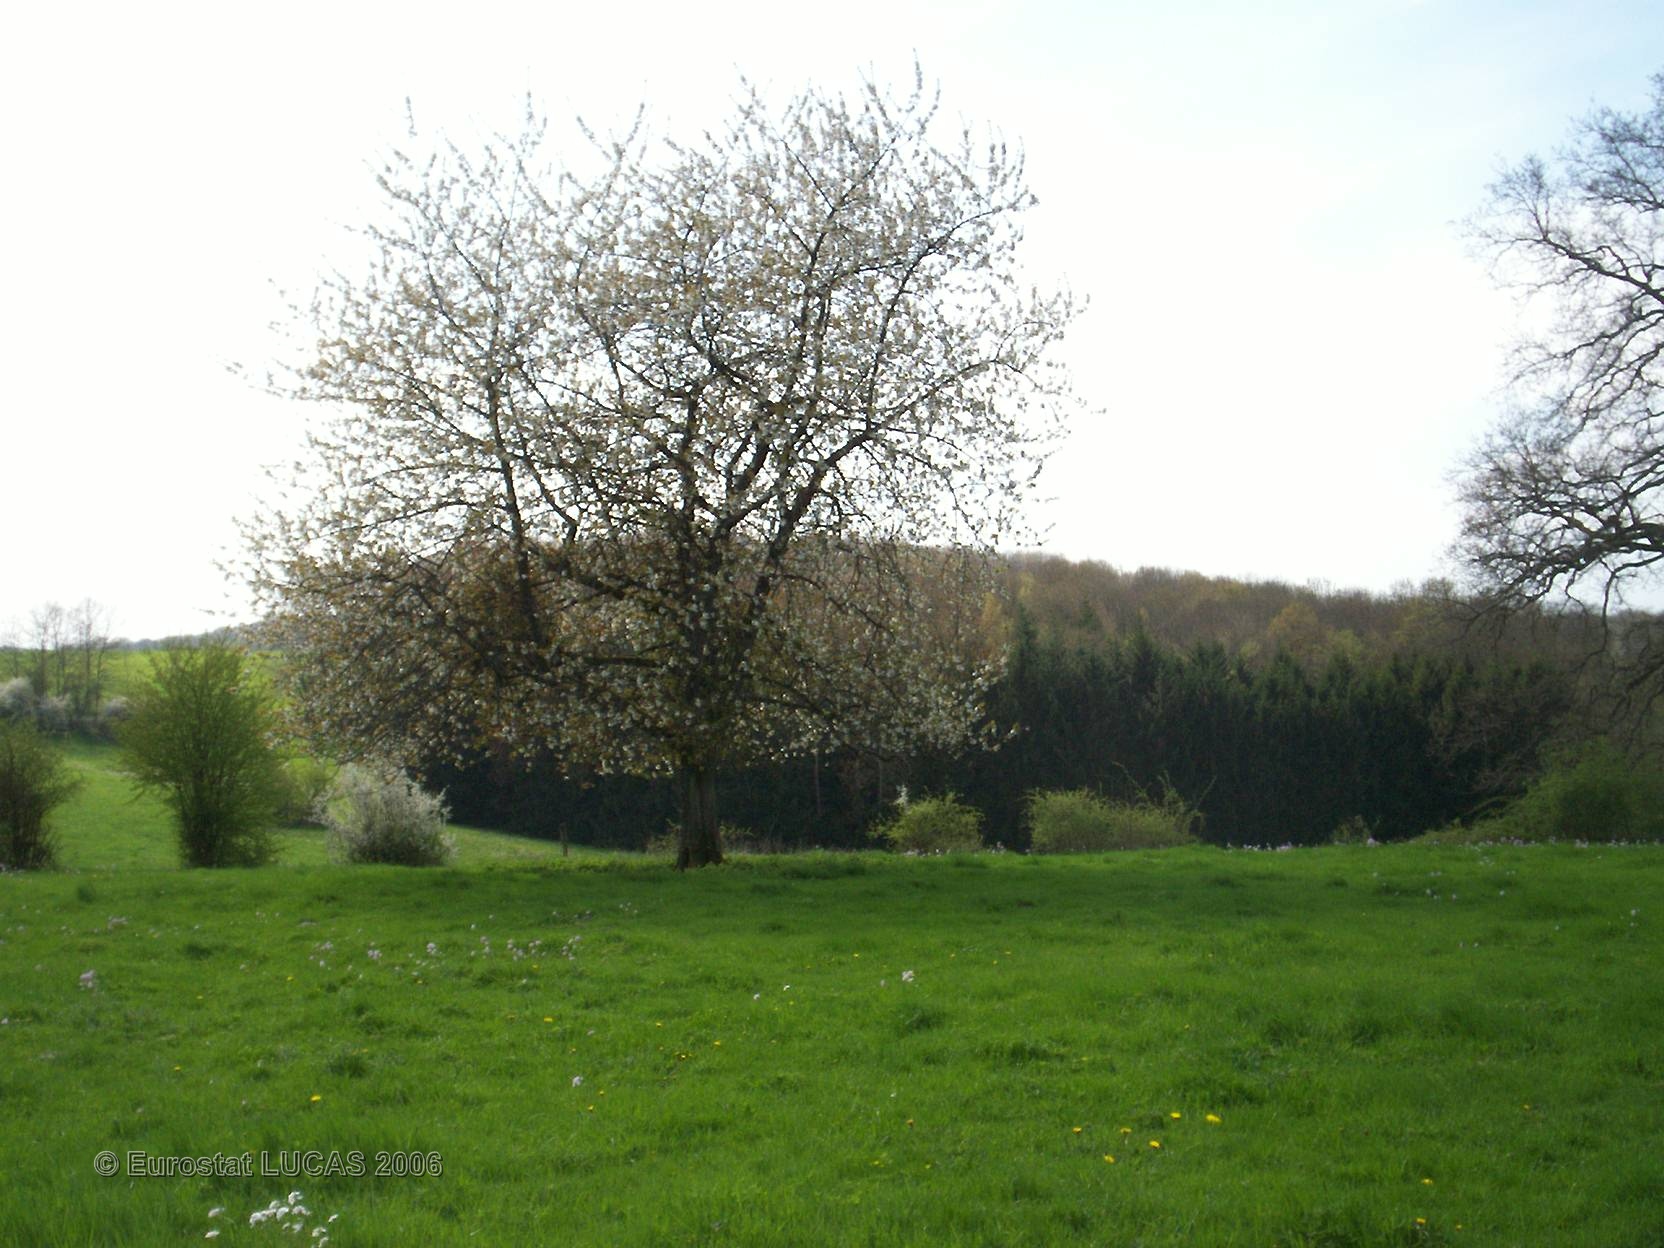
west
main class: Grassland
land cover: Grassland without tree/shrub cover
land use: Agriculture (excluding fallow land and kitchen gardens)
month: April
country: FR
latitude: 49.7721
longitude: 4.3164
